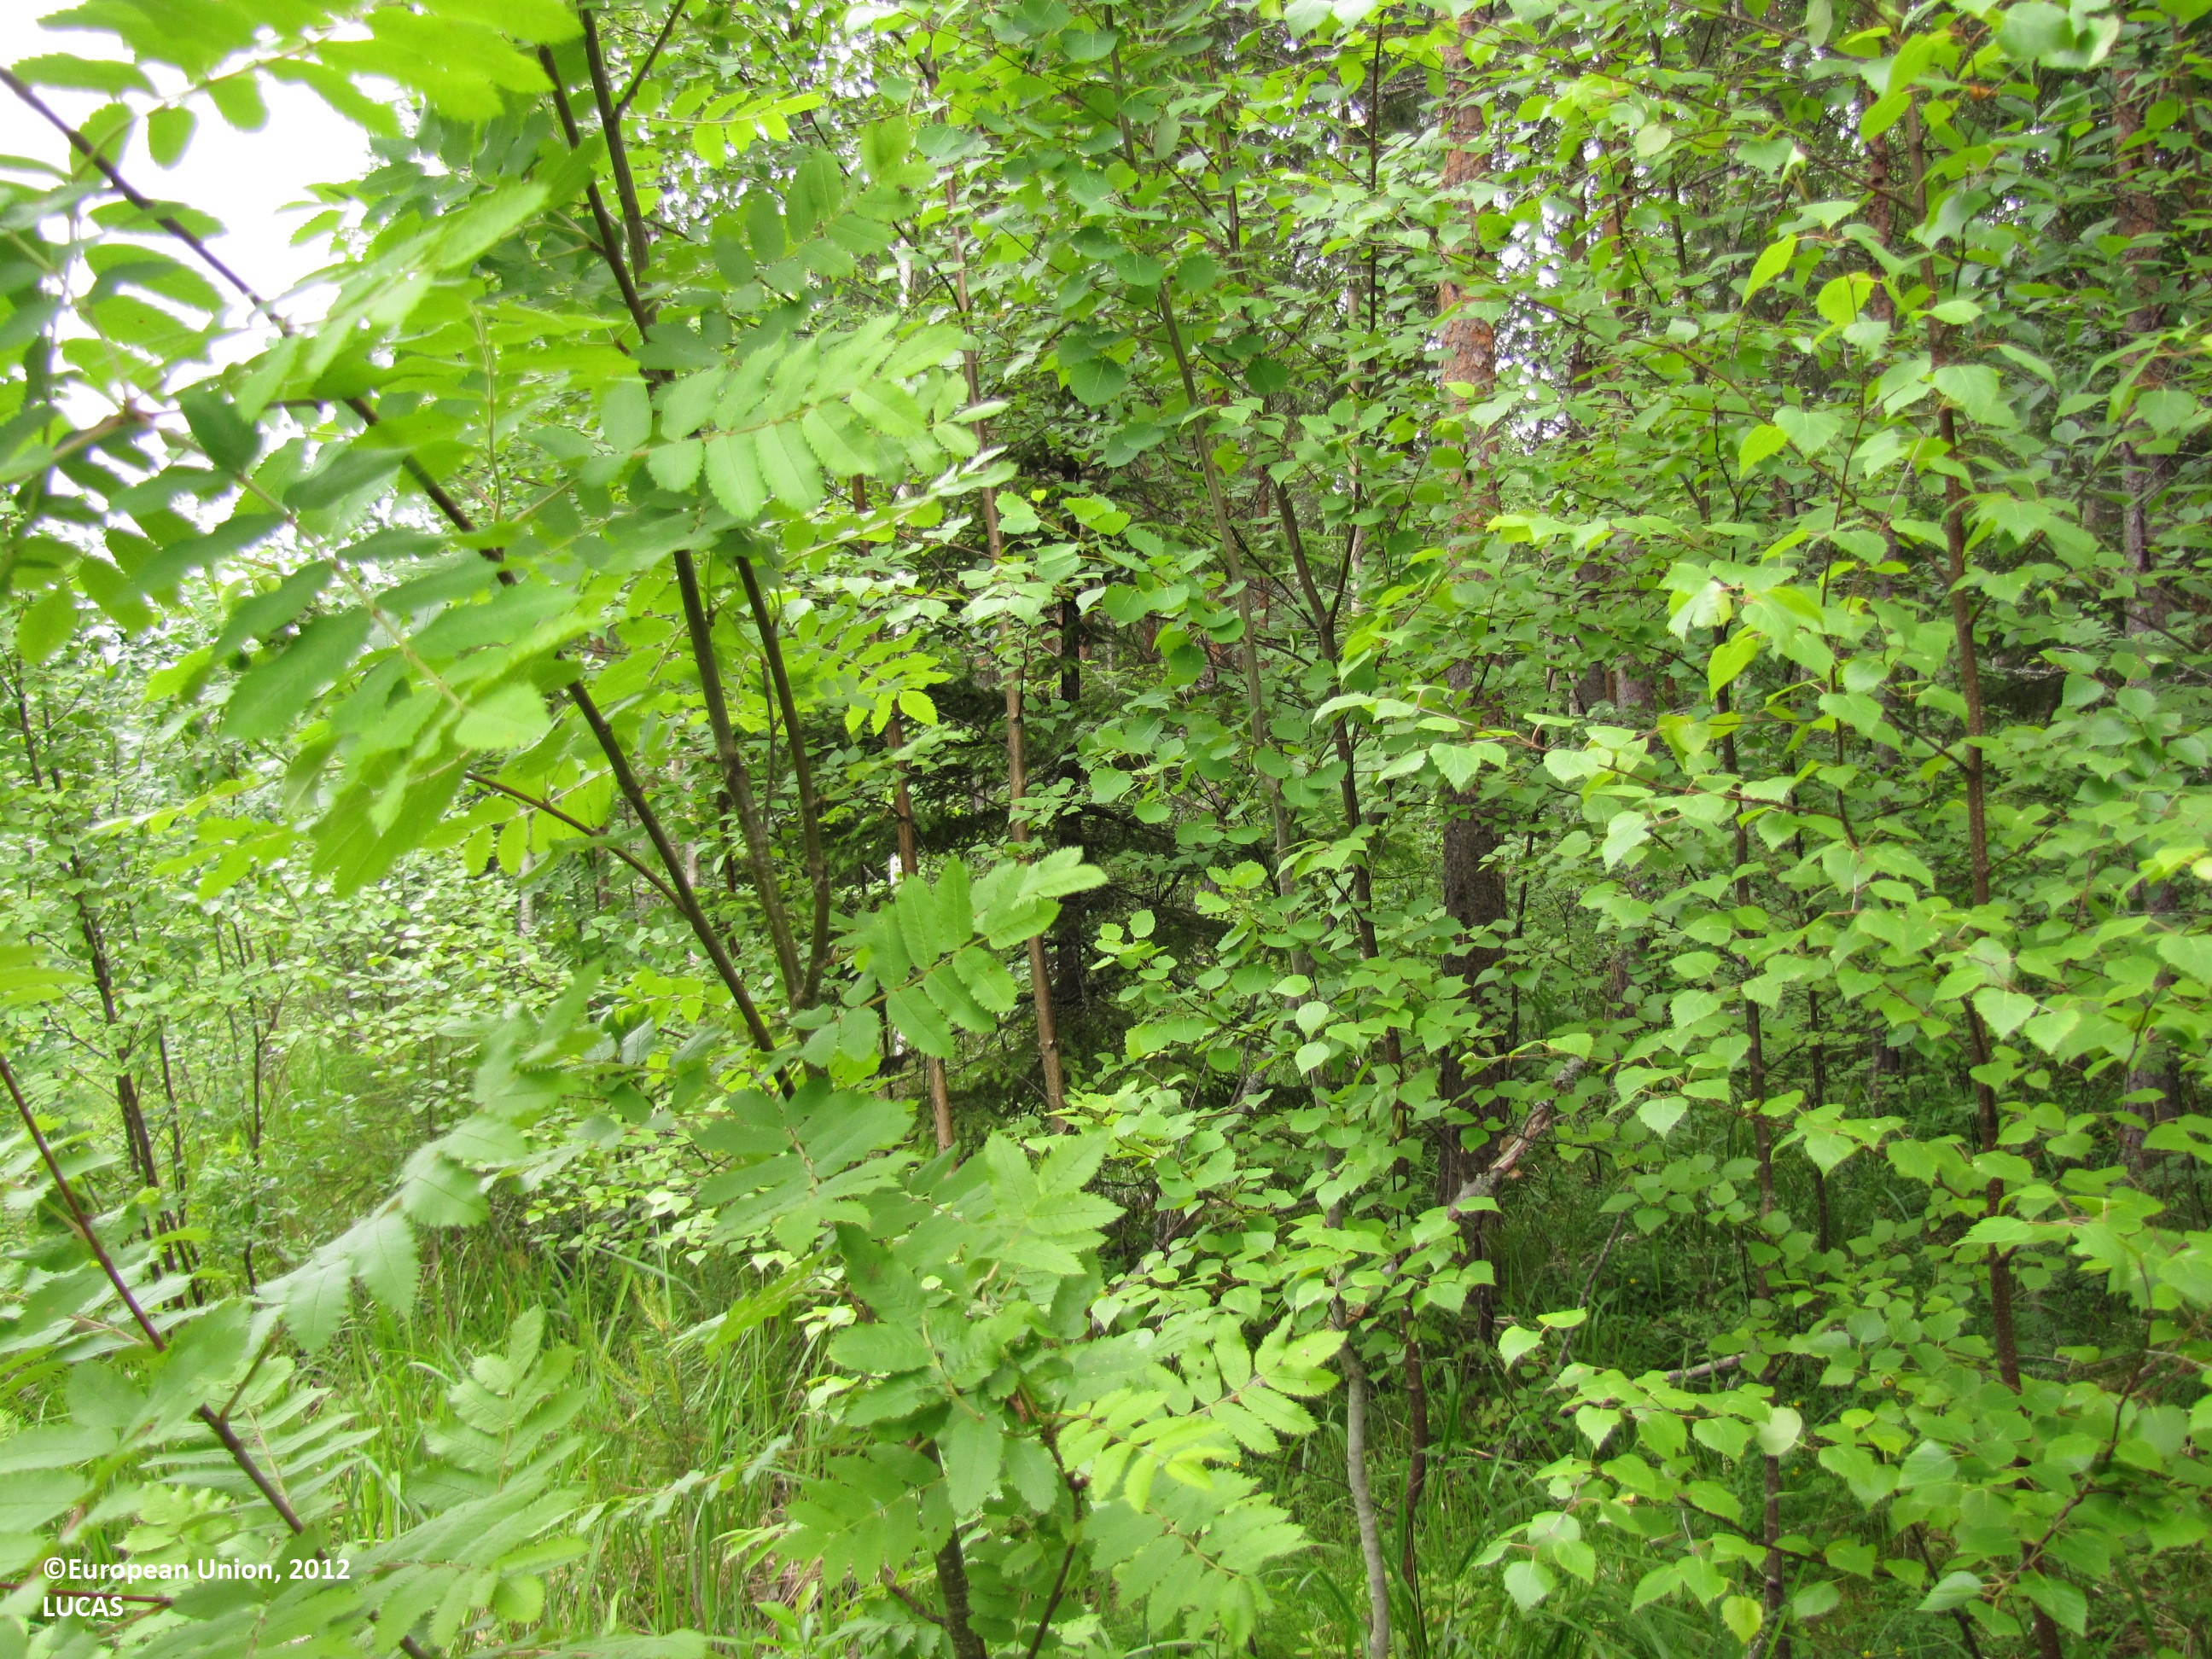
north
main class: Woodland
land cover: Pine dominated mixed woodland
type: boreal forest
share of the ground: 25 - 50 %
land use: Forestry
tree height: > 5 m
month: June
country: FI
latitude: 61.8058
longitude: 24.5740
